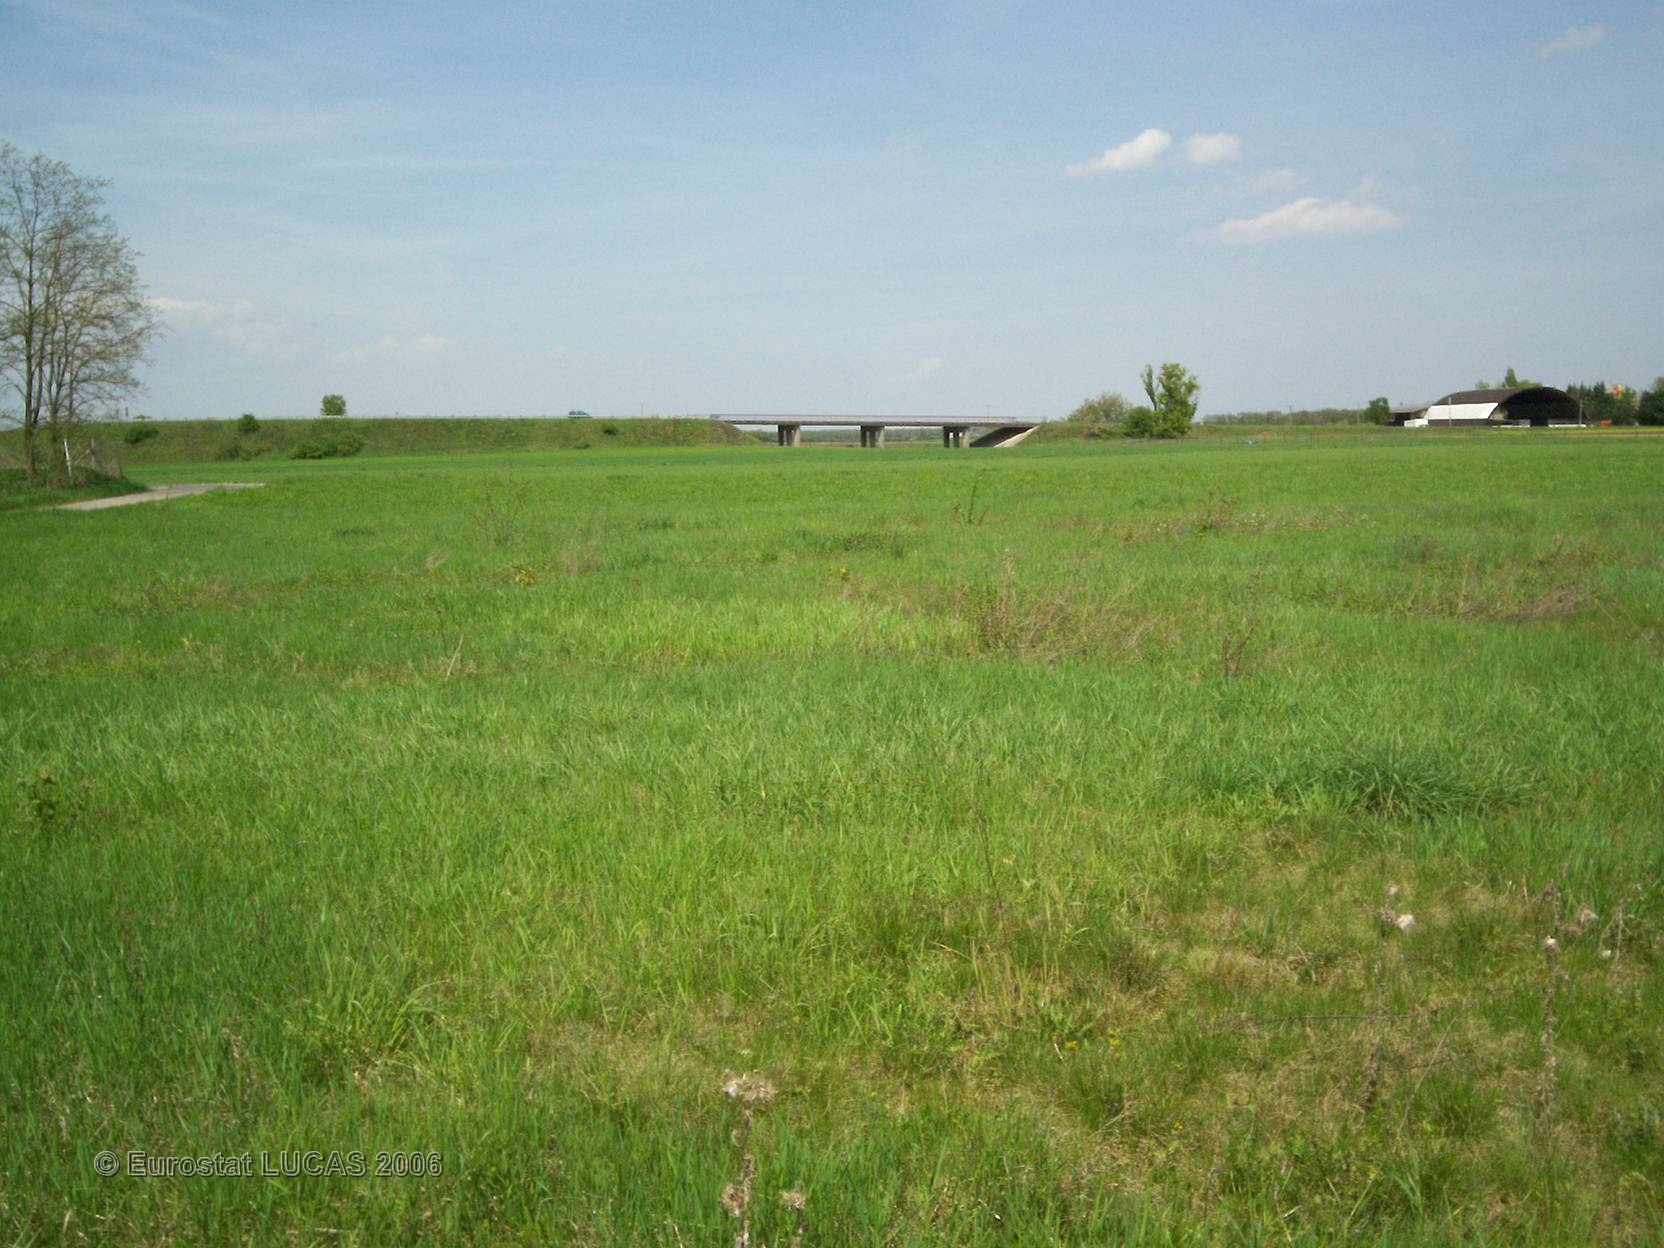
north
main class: Grassland
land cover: Grassland without tree/shrub cover
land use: Fallow land
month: May
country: FR
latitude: 47.7254
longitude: 7.4284
